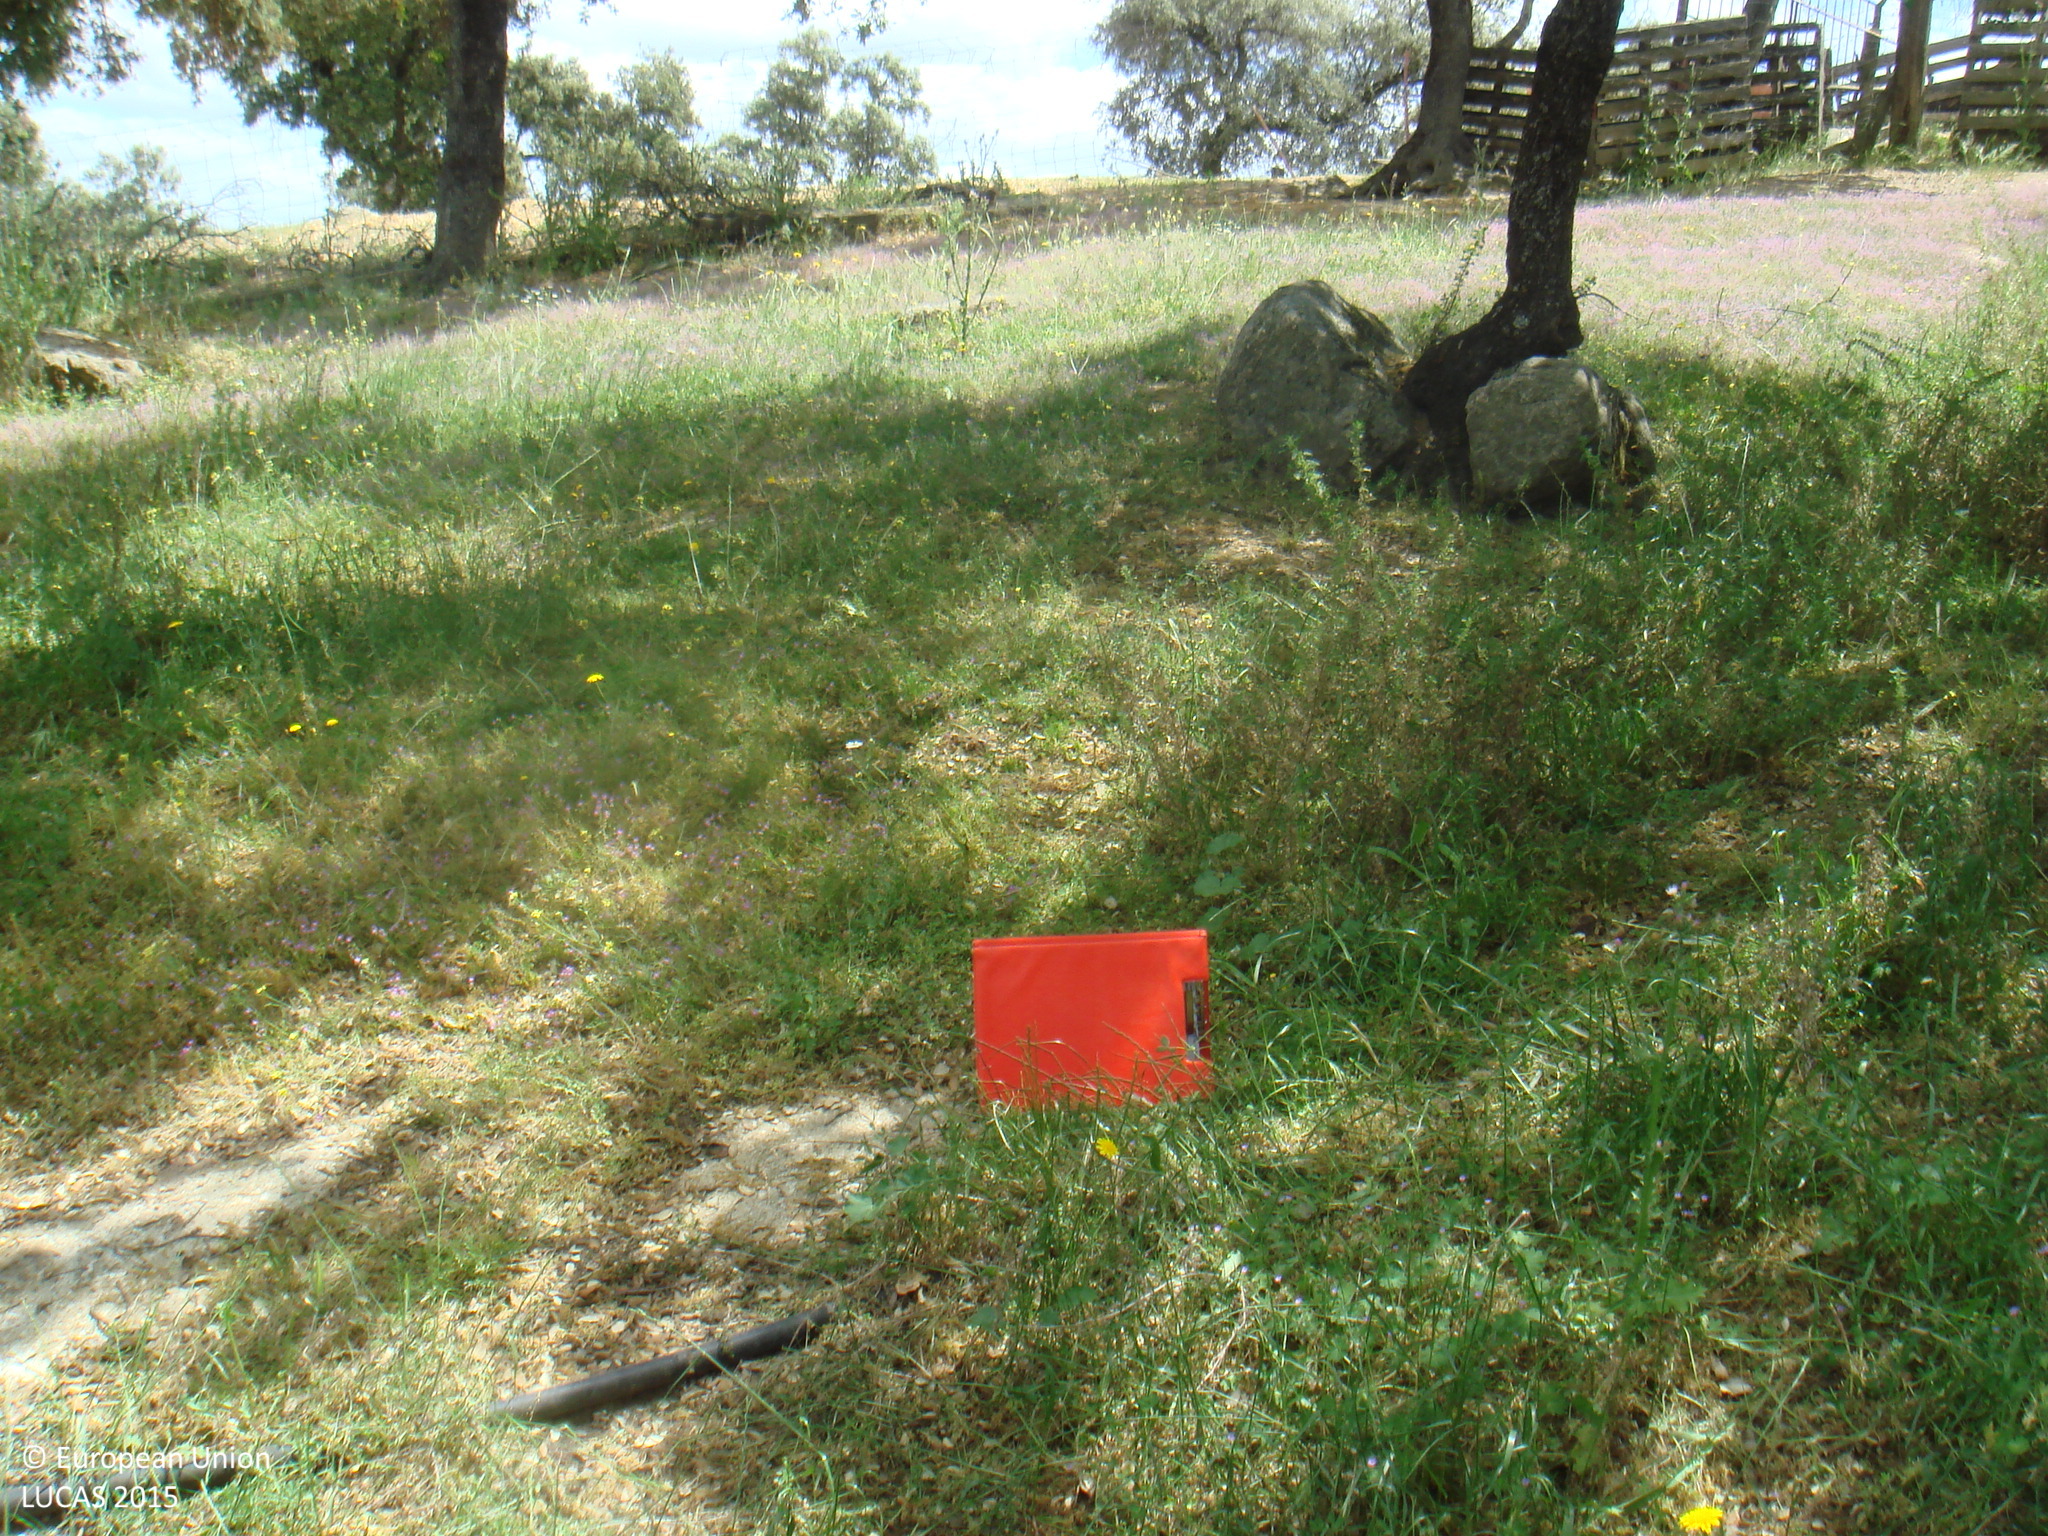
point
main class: Woodland
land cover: Broadleaved woodland
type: broadleaved evergreen forest
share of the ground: 50 - 75 %
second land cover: Spontaneously vegetated surfaces
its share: > 75 %
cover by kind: herbaceous plants 60 %, broadleaved forest trees 40 %
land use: Forestry
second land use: Agriculture (excluding fallow land and kitchen gardens)
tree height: > 5 m
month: May
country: ES
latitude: 38.3111
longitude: -4.3224
